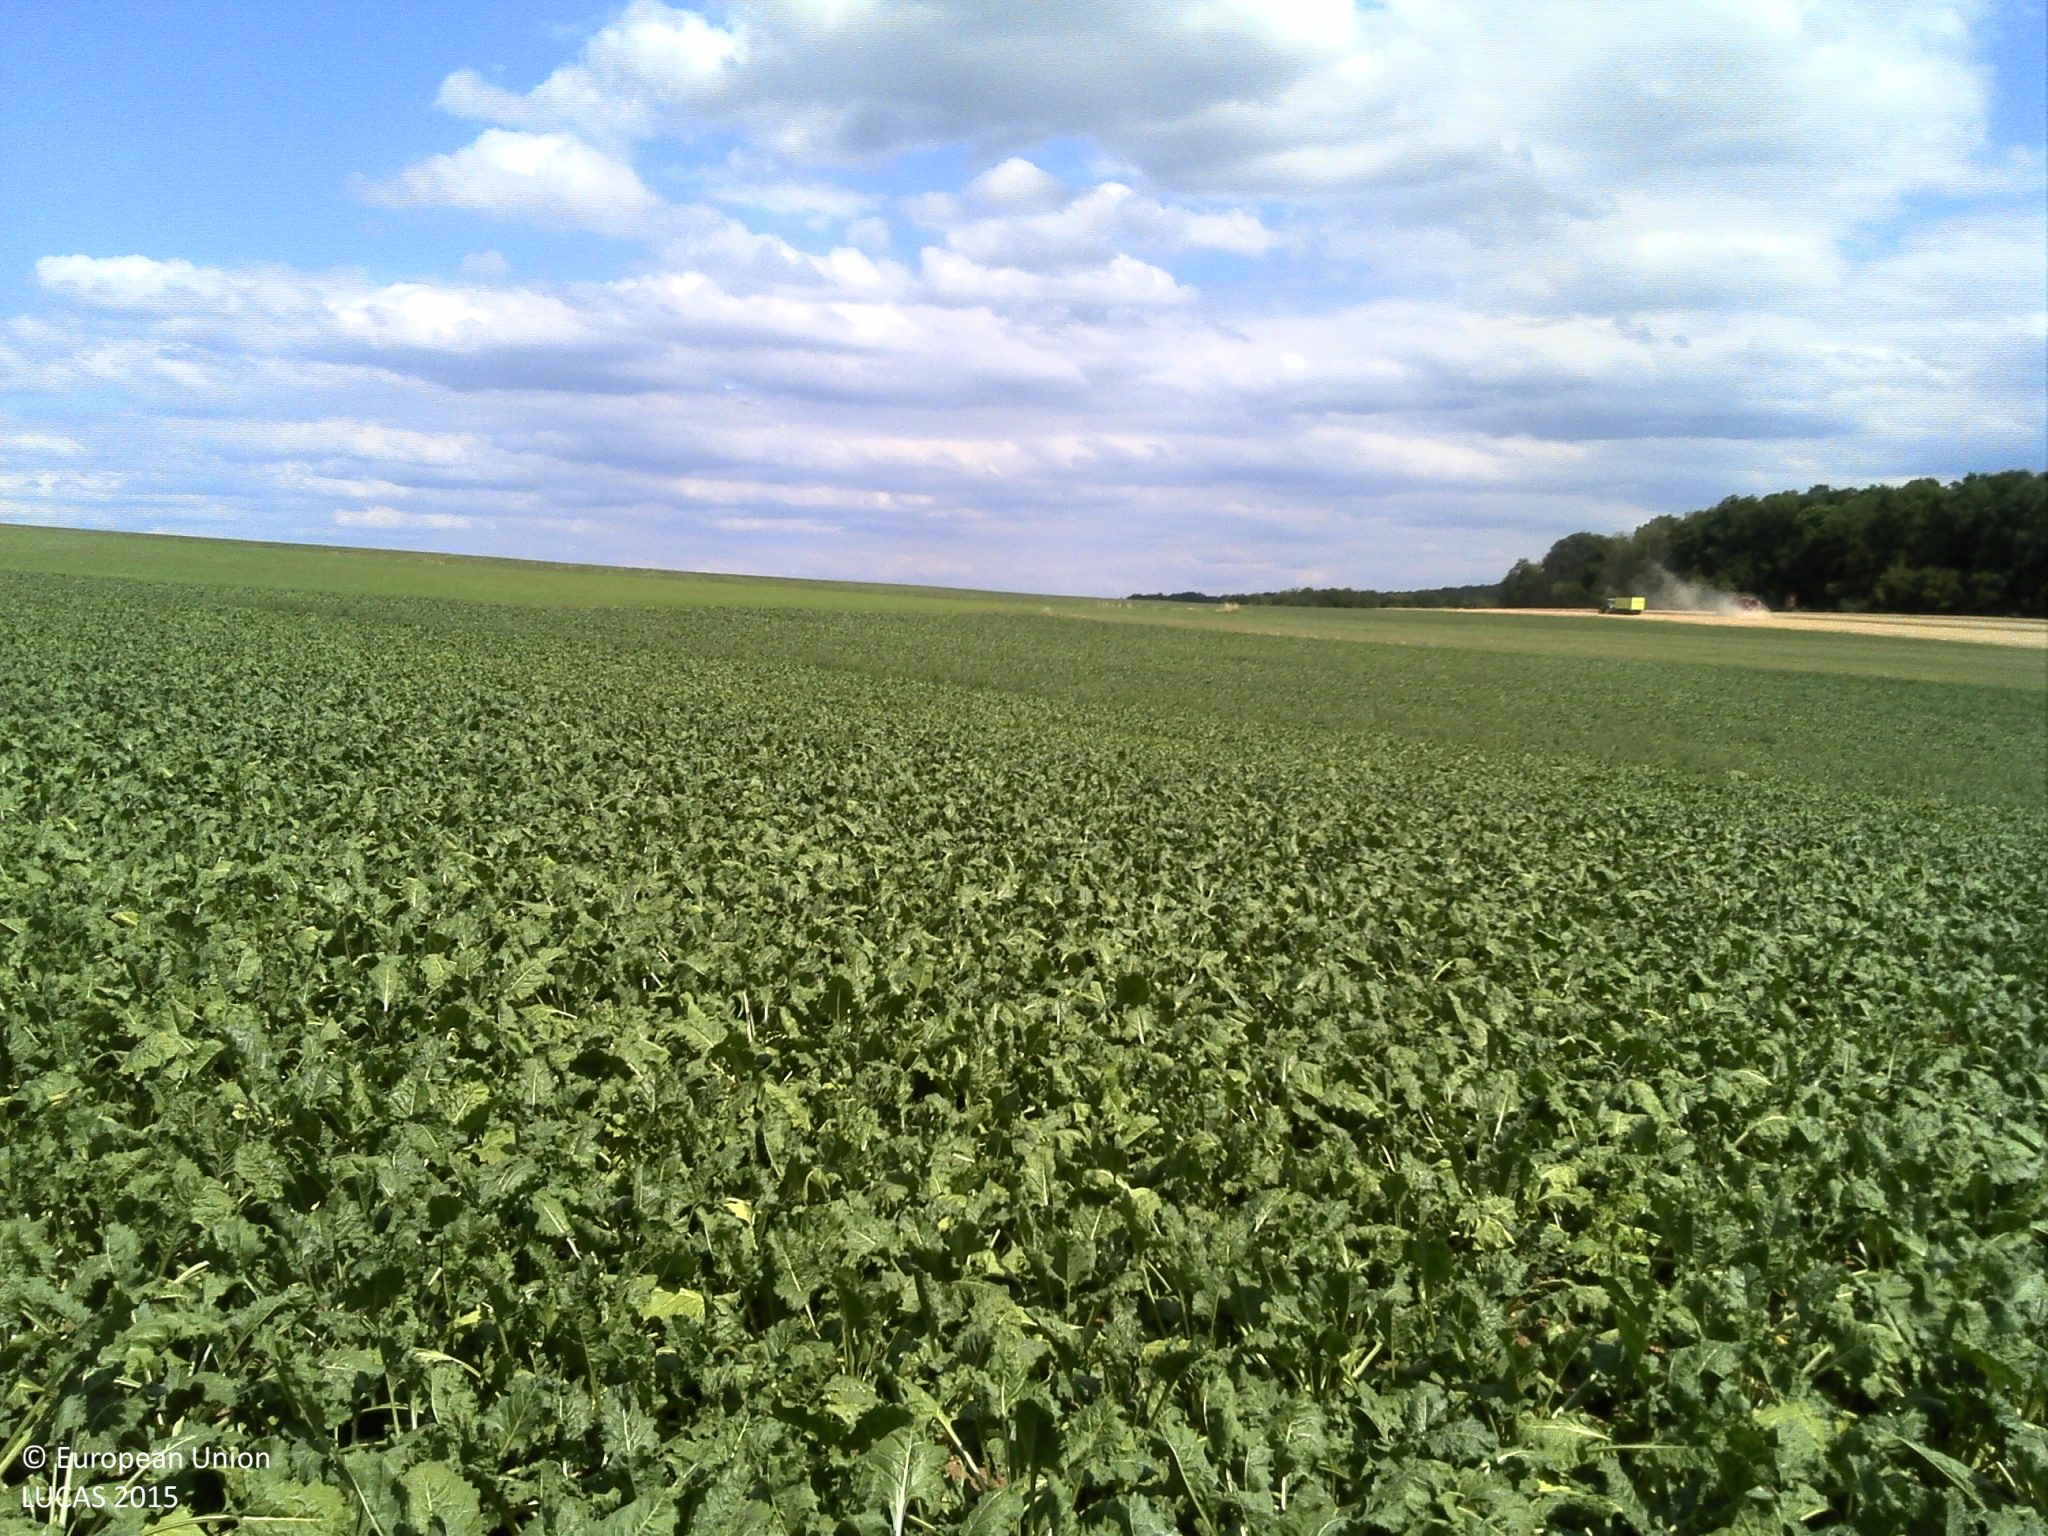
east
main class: Cropland
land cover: Sugar beet
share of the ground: > 75 %
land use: Agriculture (excluding fallow land and kitchen gardens)
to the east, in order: Sugar beet; Clovers; Ditches and canals
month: July
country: FR
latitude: 49.1670
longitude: 7.4907
